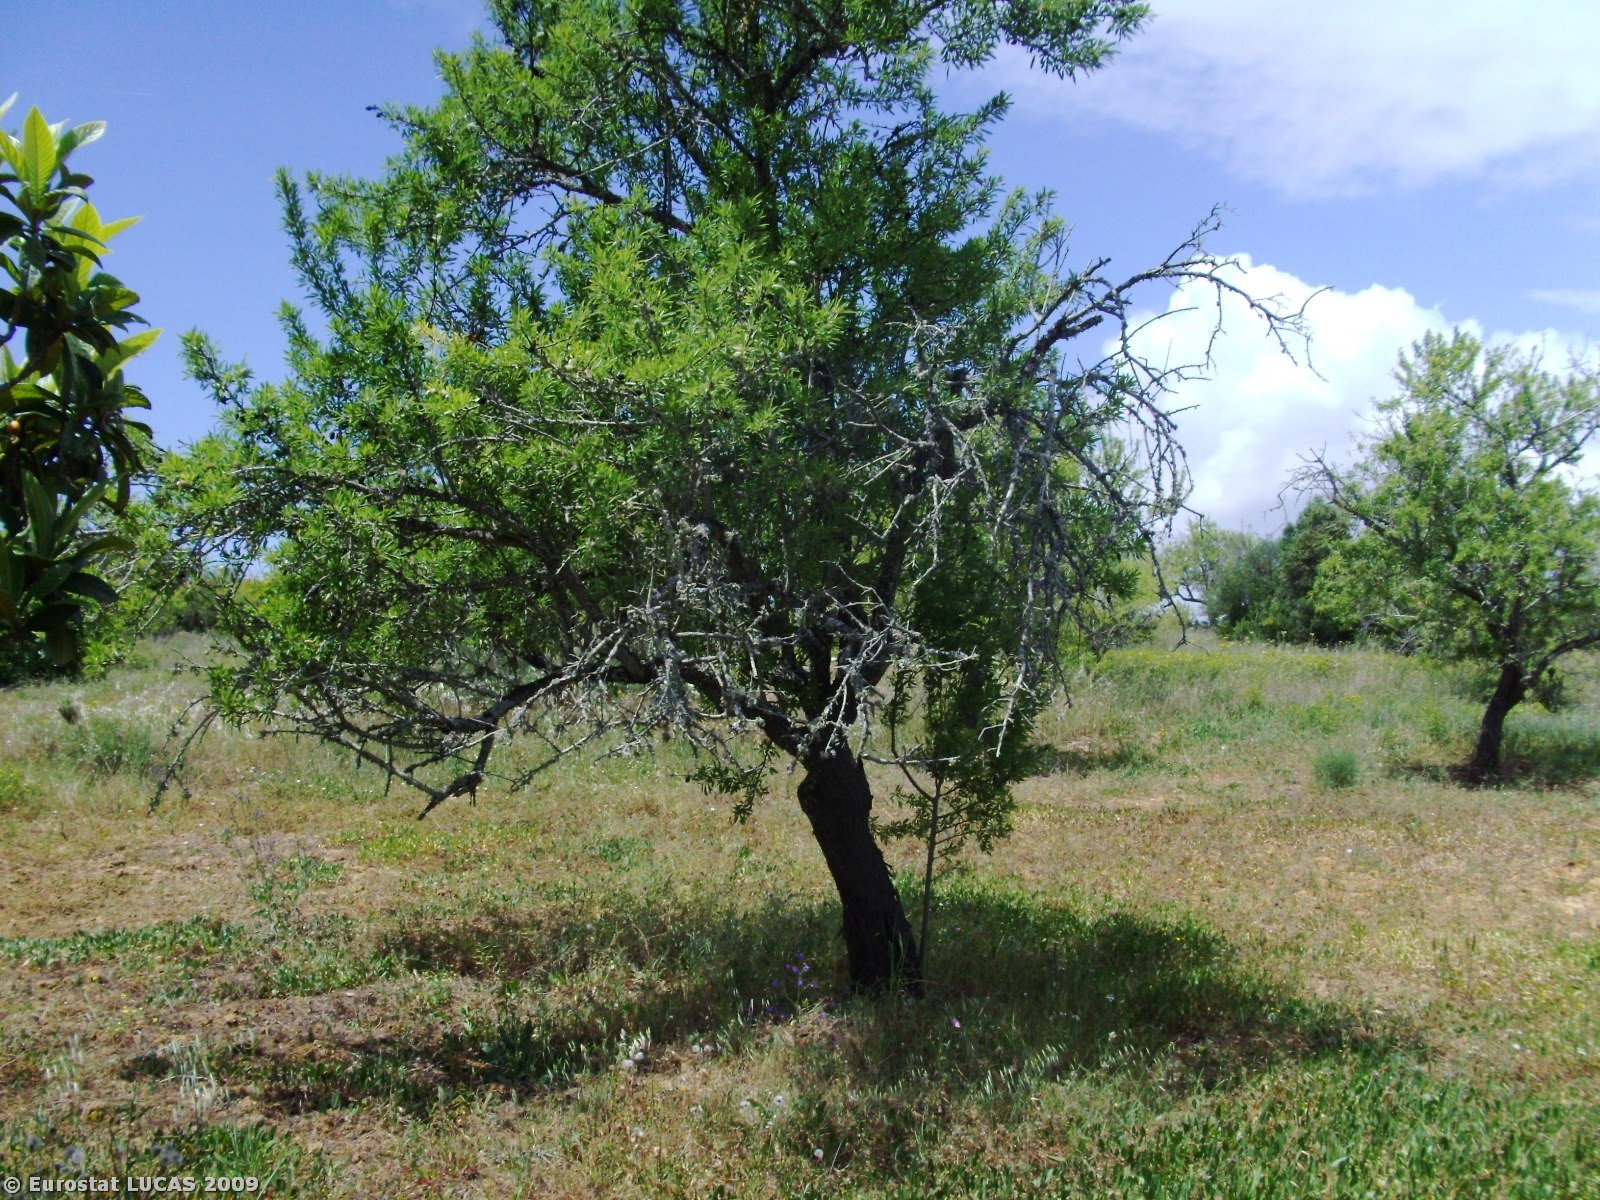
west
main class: Cropland
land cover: Permanent industrial crops
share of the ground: 10 - 25 %
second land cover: Spontaneously vegetated surfaces
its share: 50 - 75 %
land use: Agriculture (excluding fallow land and kitchen gardens)
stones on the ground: 10 - 25 %
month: May
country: PT
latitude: 37.1082
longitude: -8.4667
